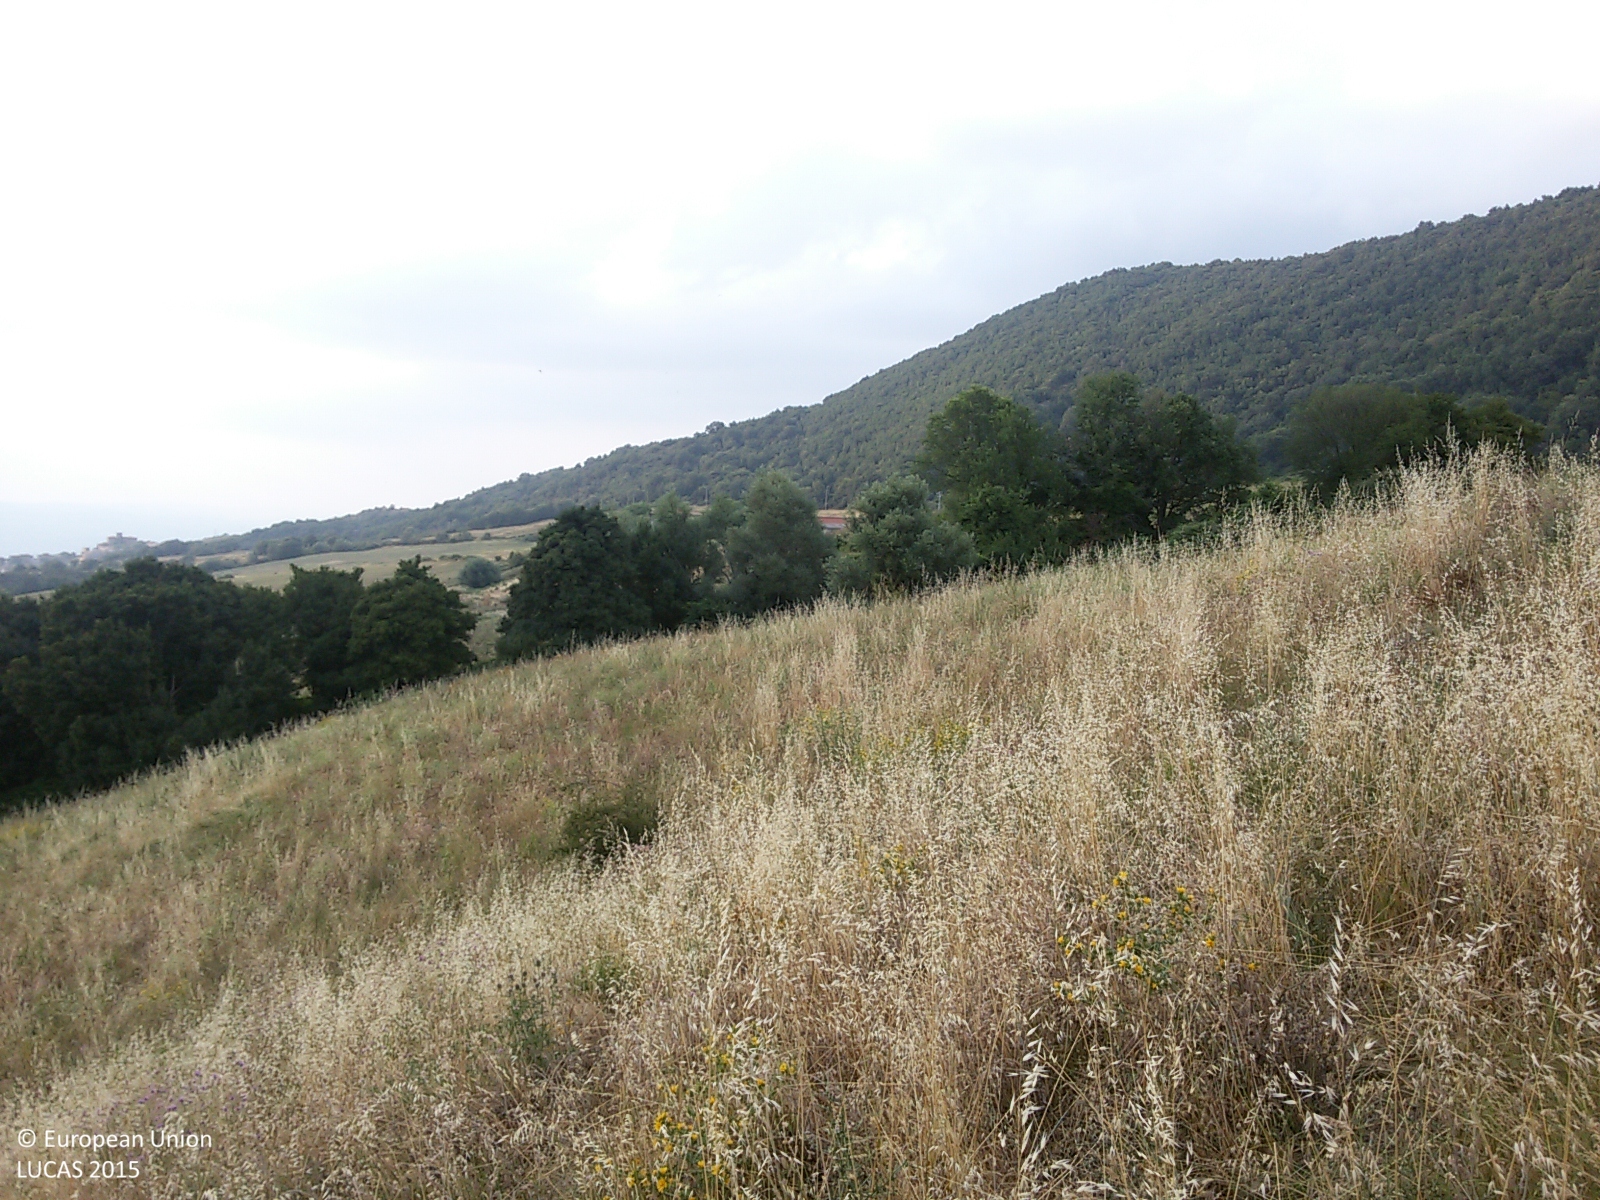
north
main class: Cropland
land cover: Temporary grasslands
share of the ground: > 75 %
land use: Agriculture (excluding fallow land and kitchen gardens)
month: July
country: IT
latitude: 42.8604
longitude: 11.4518
